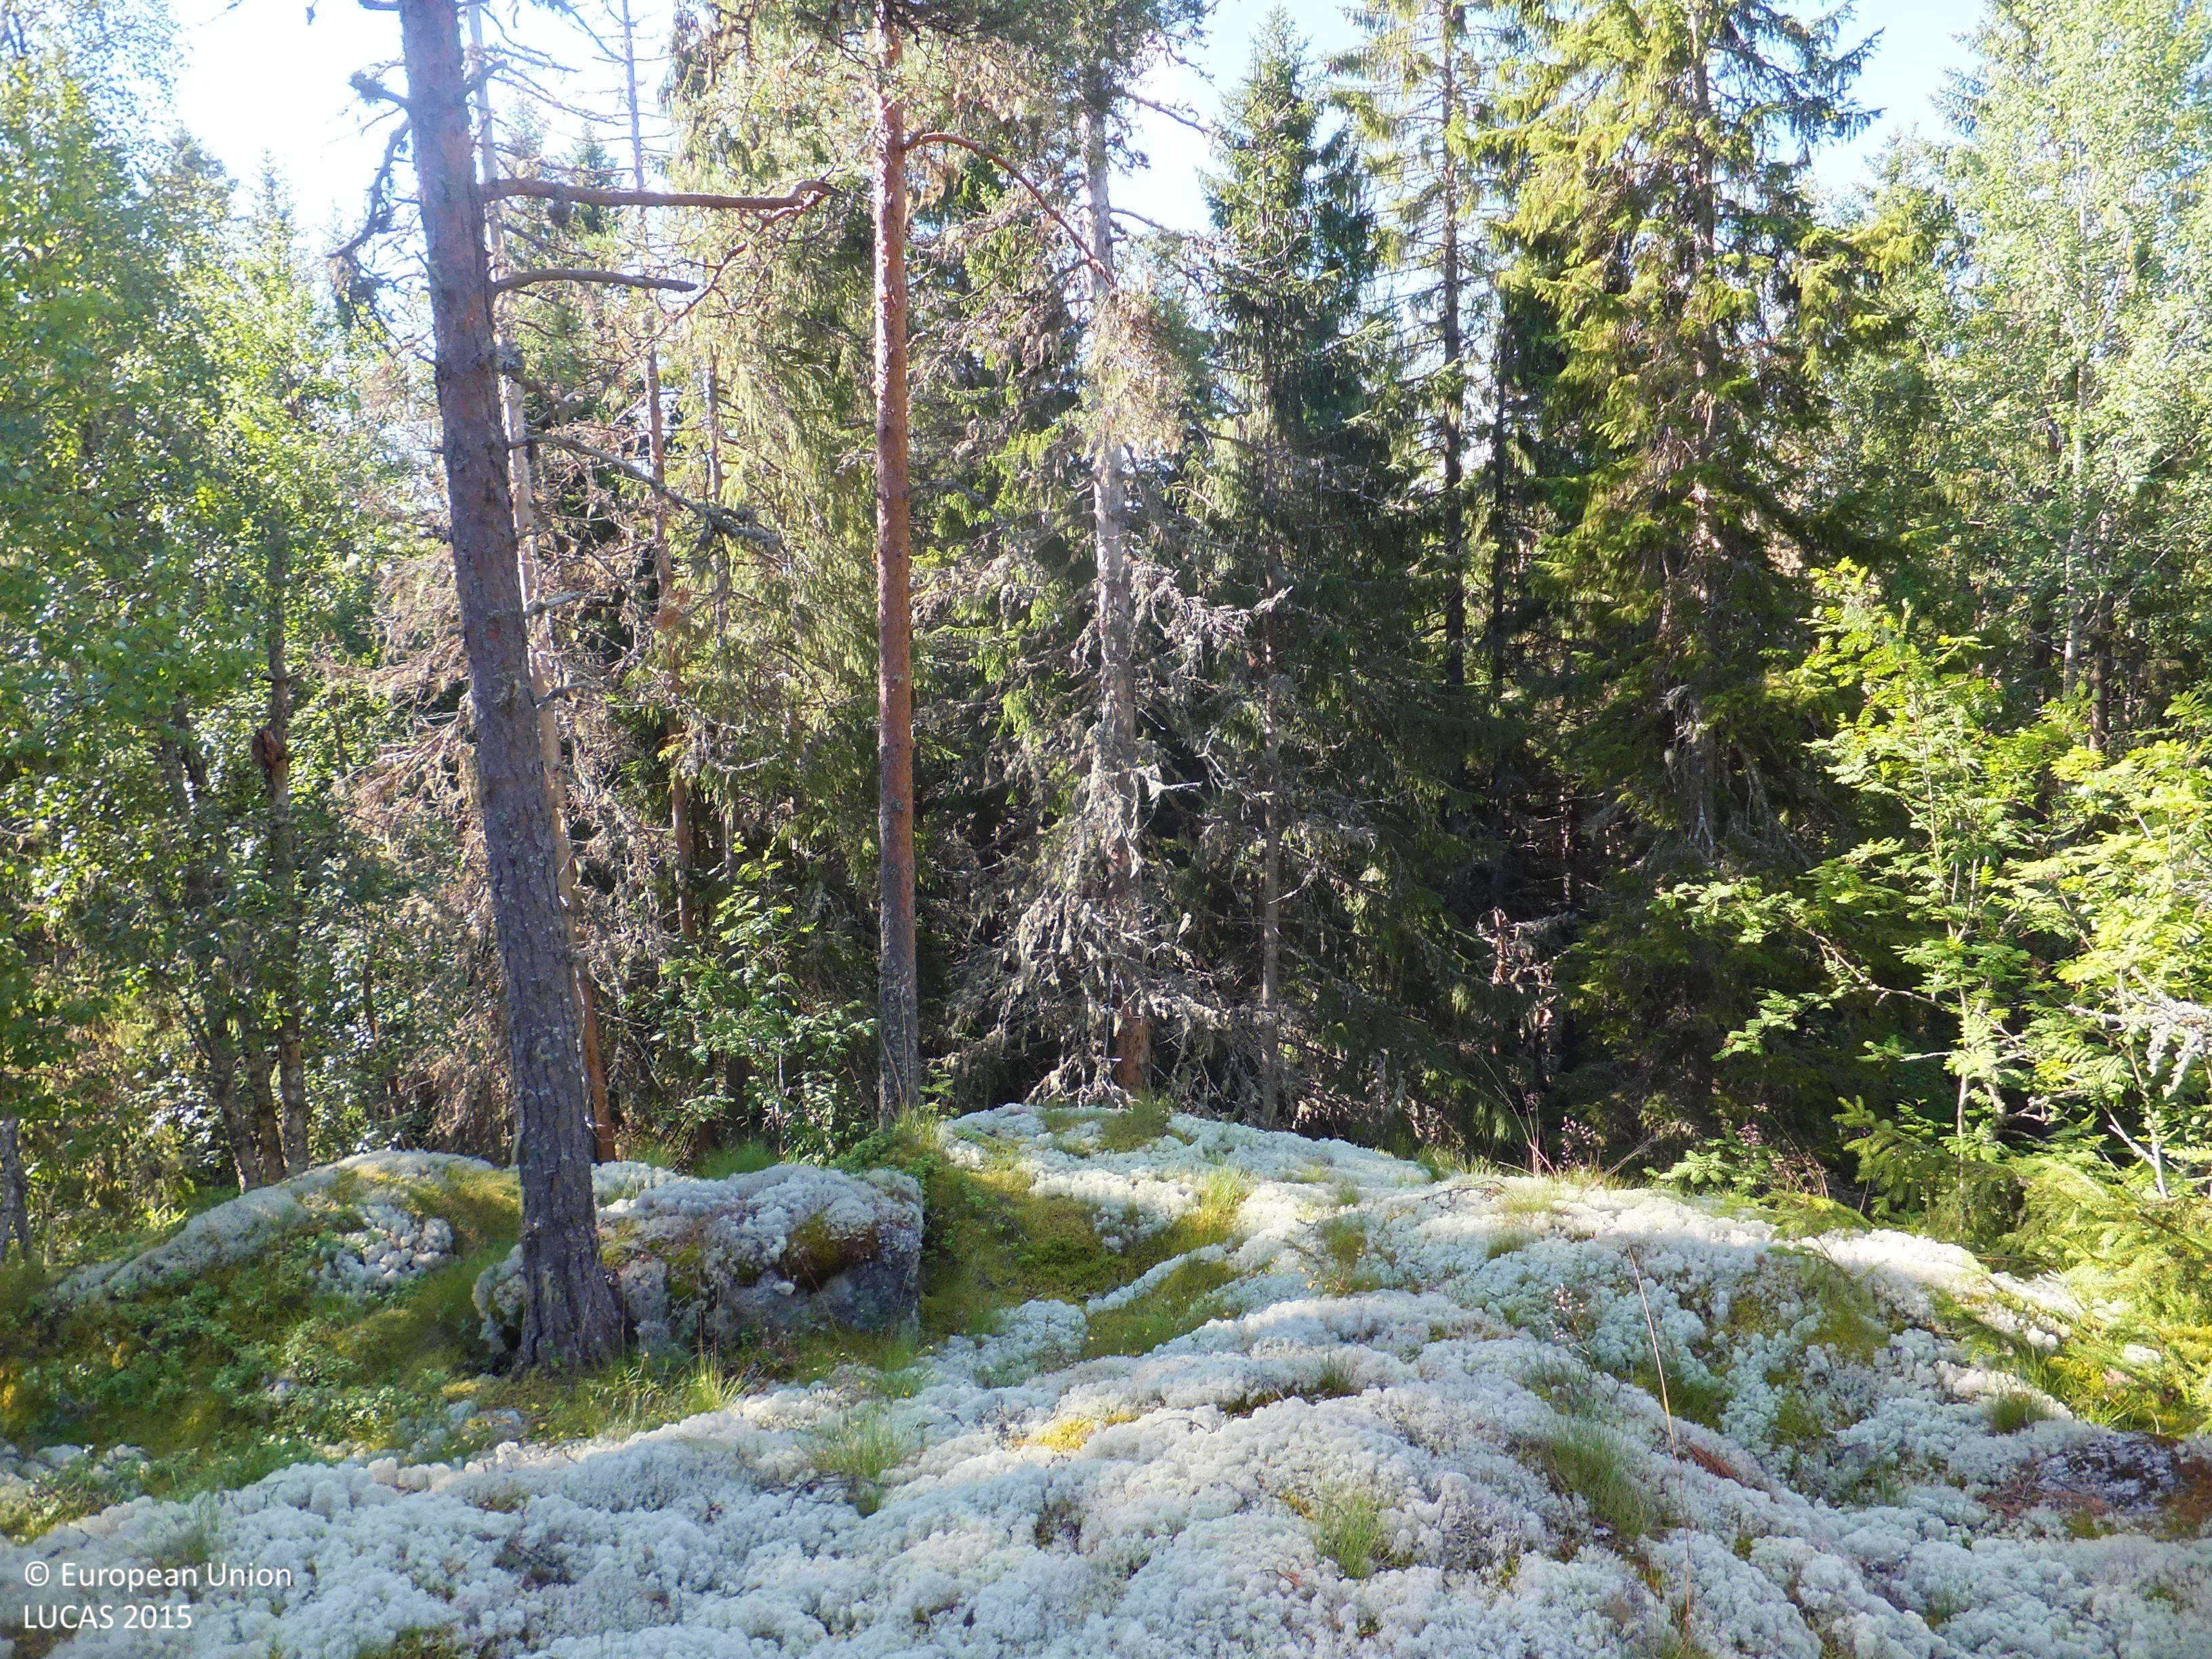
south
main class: Woodland
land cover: Pine dominated mixed woodland
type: boreal forest
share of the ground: 25 - 50 %
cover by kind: lichens and mosses 30 %, shrubs 25 %, coniferous forest trees 20 %, broadleaved forest trees 10 %, herbaceous plants 10 %, consolidated bare surface 5 %
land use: Forestry
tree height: > 5 m
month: August
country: FI
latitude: 63.1149
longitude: 22.0367
